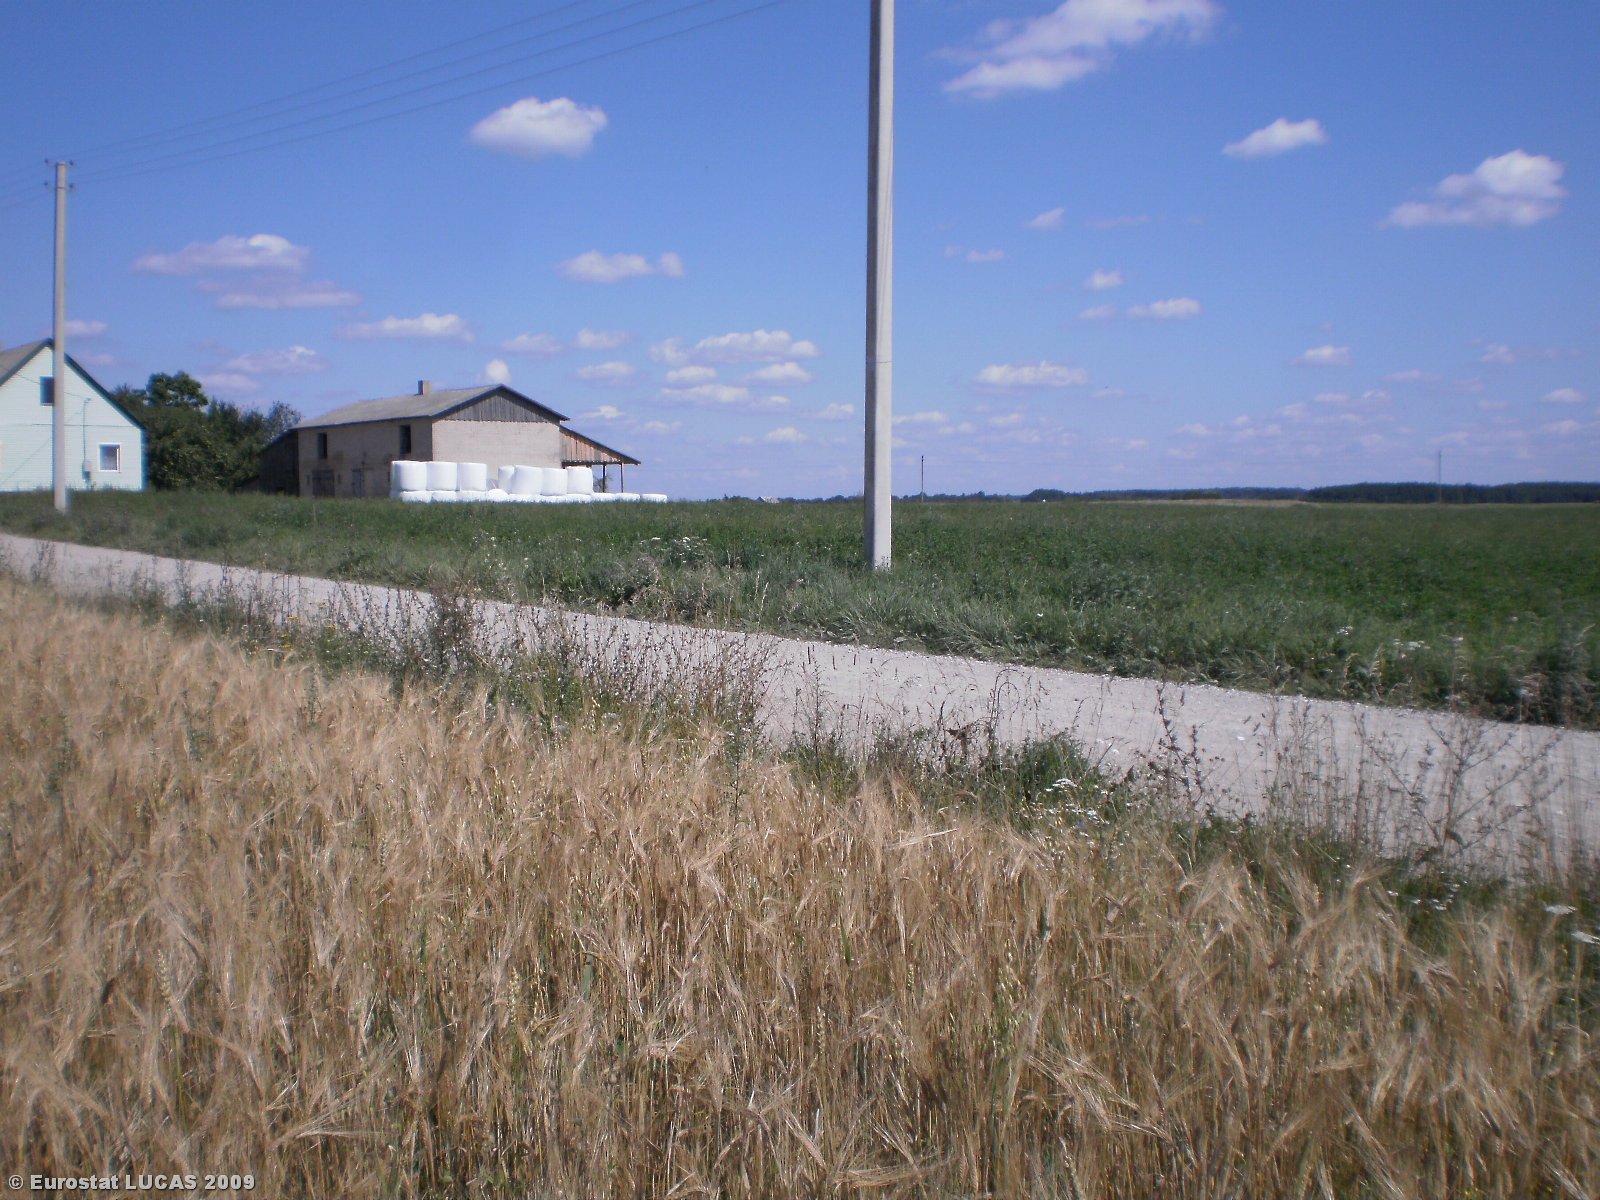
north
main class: Cropland
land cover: Barley
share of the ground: > 75 %
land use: Agriculture (excluding fallow land and kitchen gardens)
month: August
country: LT
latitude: 55.7032
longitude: 24.9893
